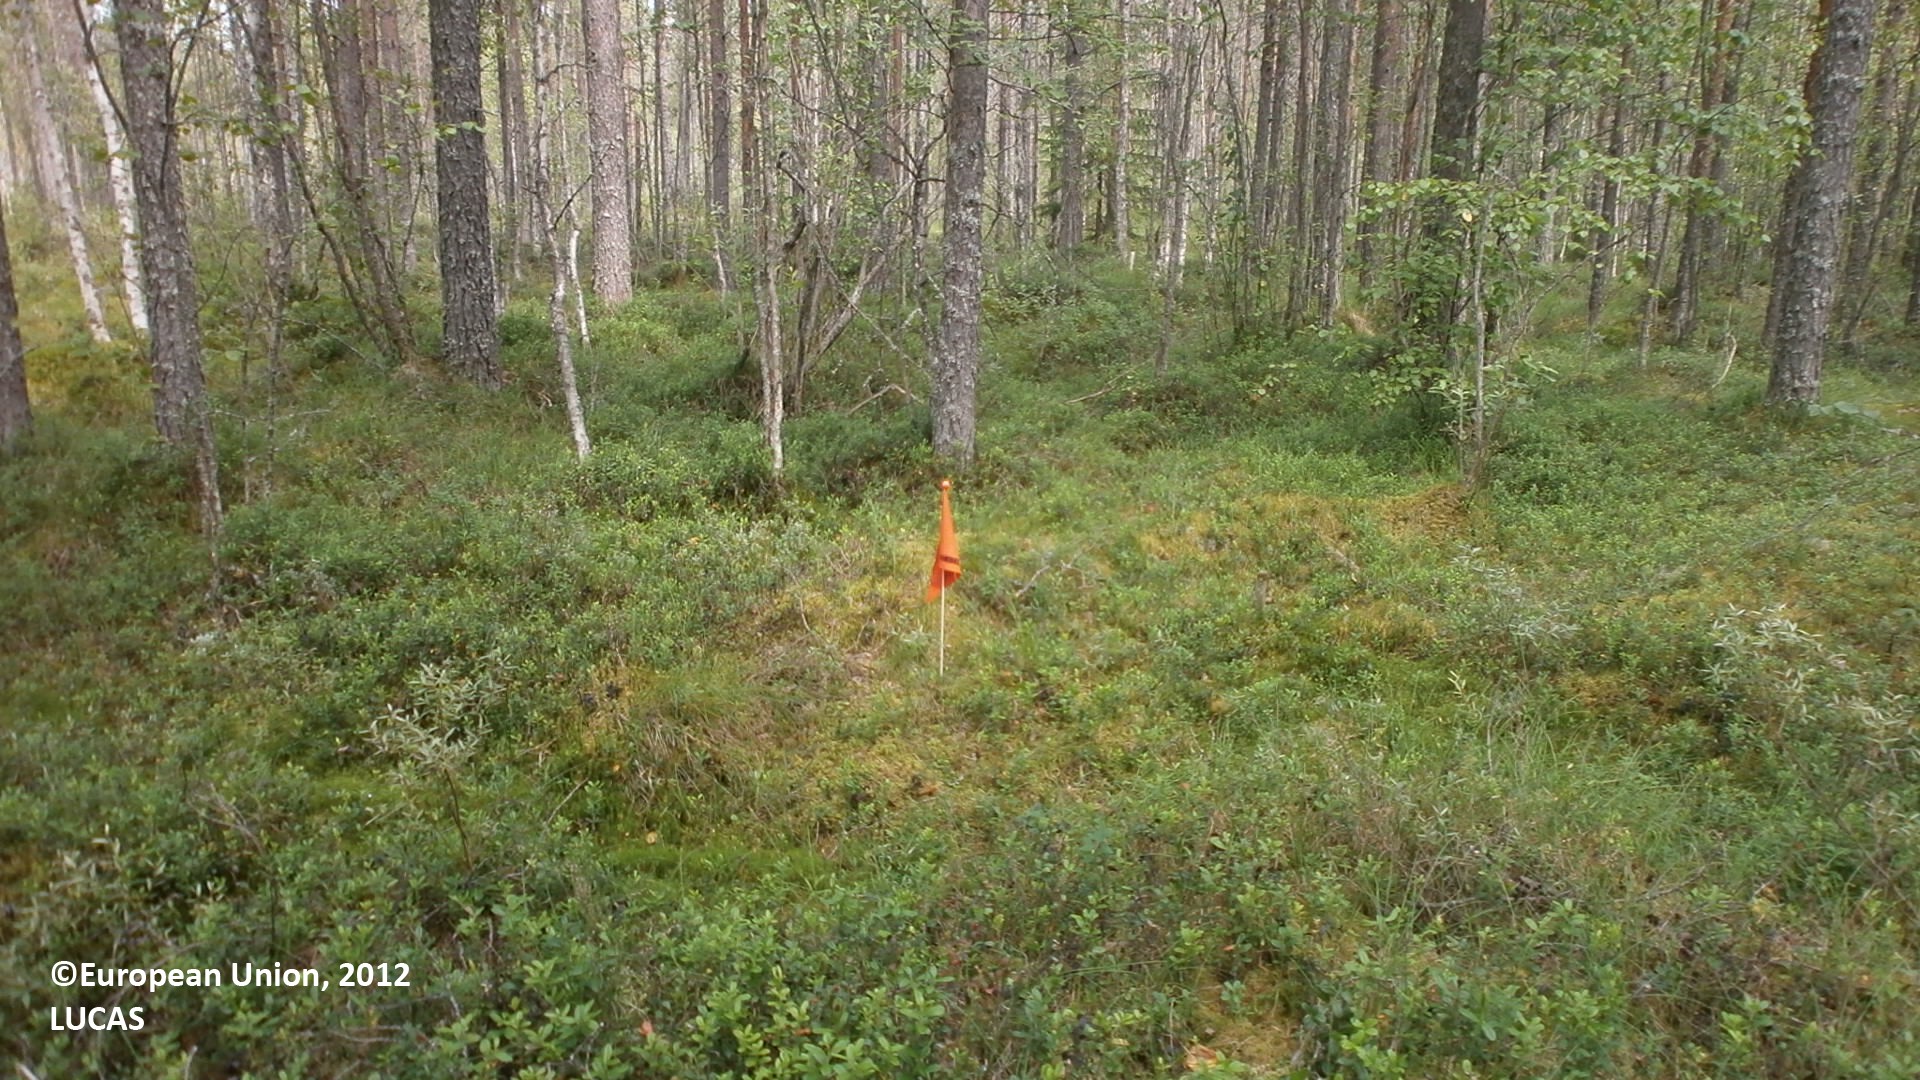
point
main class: Woodland
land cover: Pine dominated coniferous woodland
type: boreal forest
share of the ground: 50 - 75 %
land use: Forestry
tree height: > 5 m
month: July
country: FI
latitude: 64.1678
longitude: 24.9114
